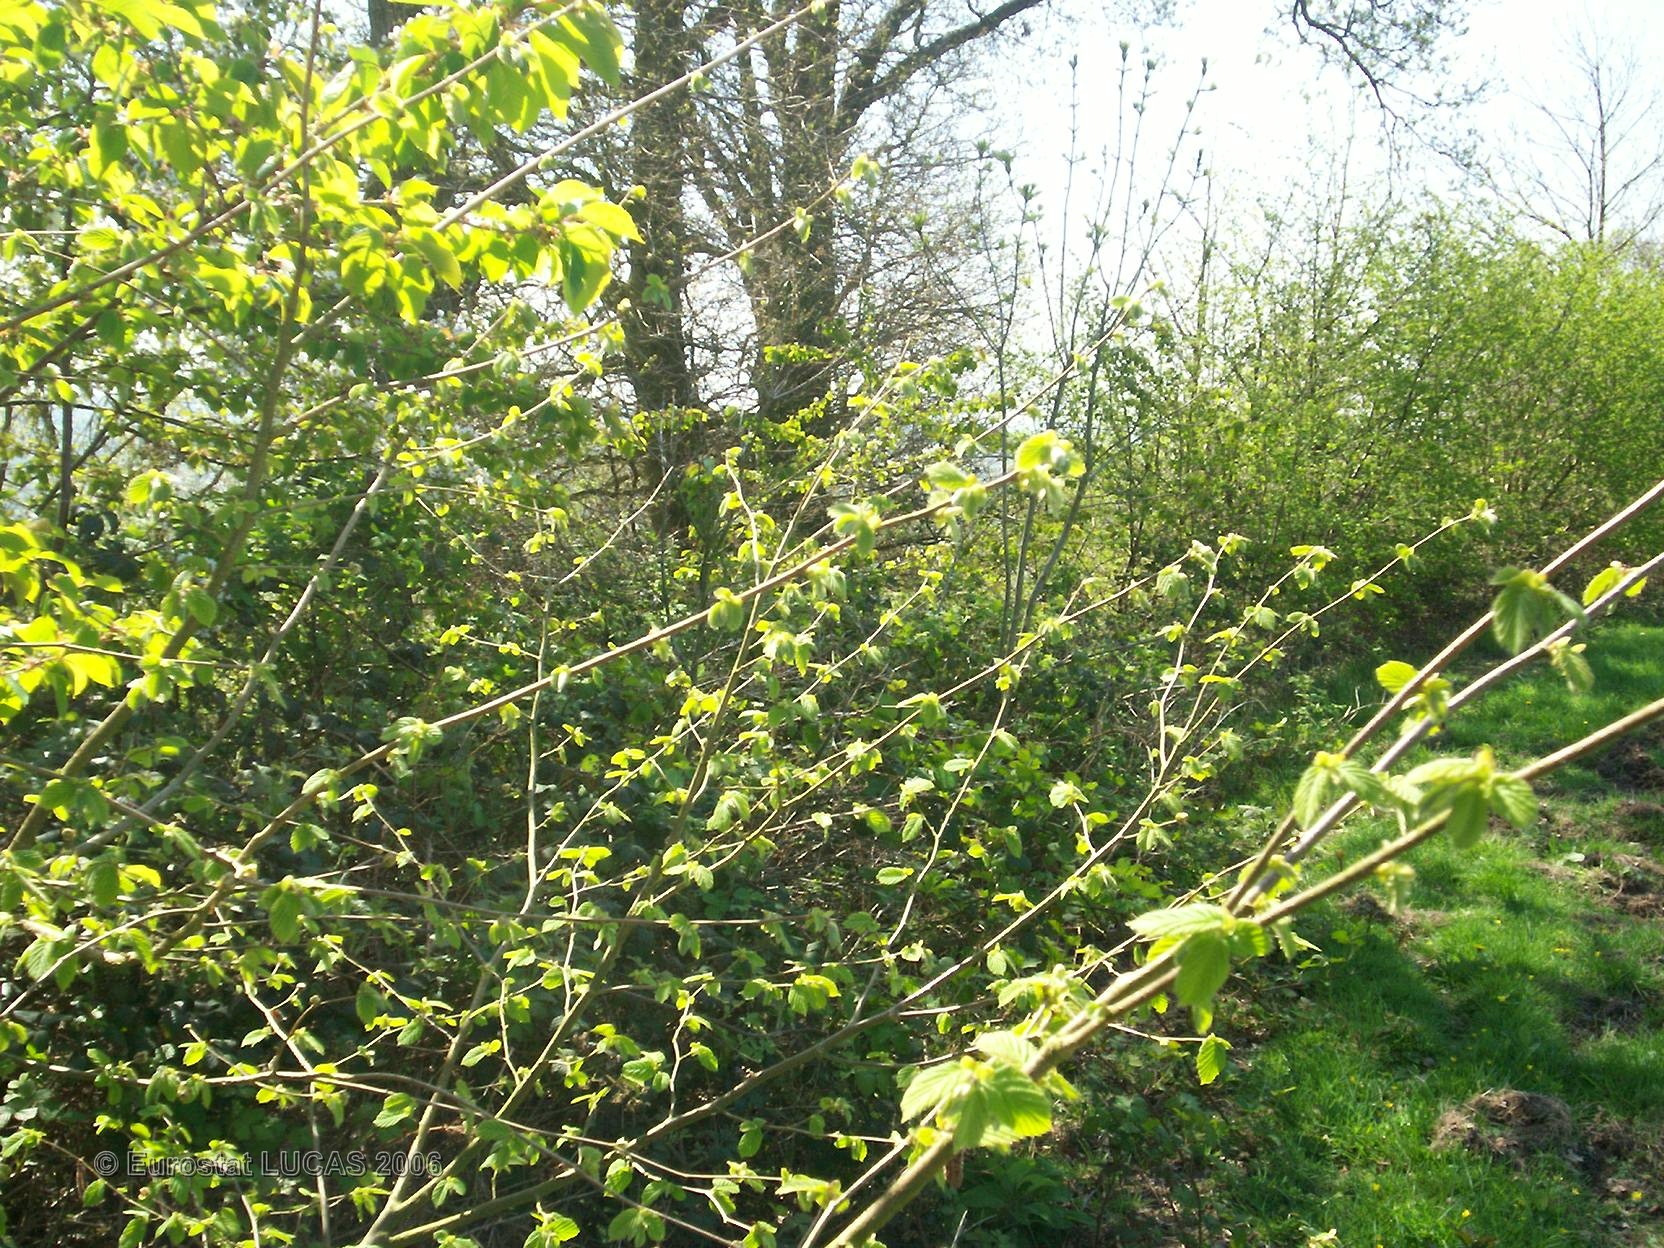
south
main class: Grassland
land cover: Grassland without tree/shrub cover
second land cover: Grassland with sparse tree/shrub cover
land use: Road transport
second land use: Agriculture (excluding fallow land and kitchen gardens)
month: April
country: FR
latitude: 49.2500
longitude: -0.0466
